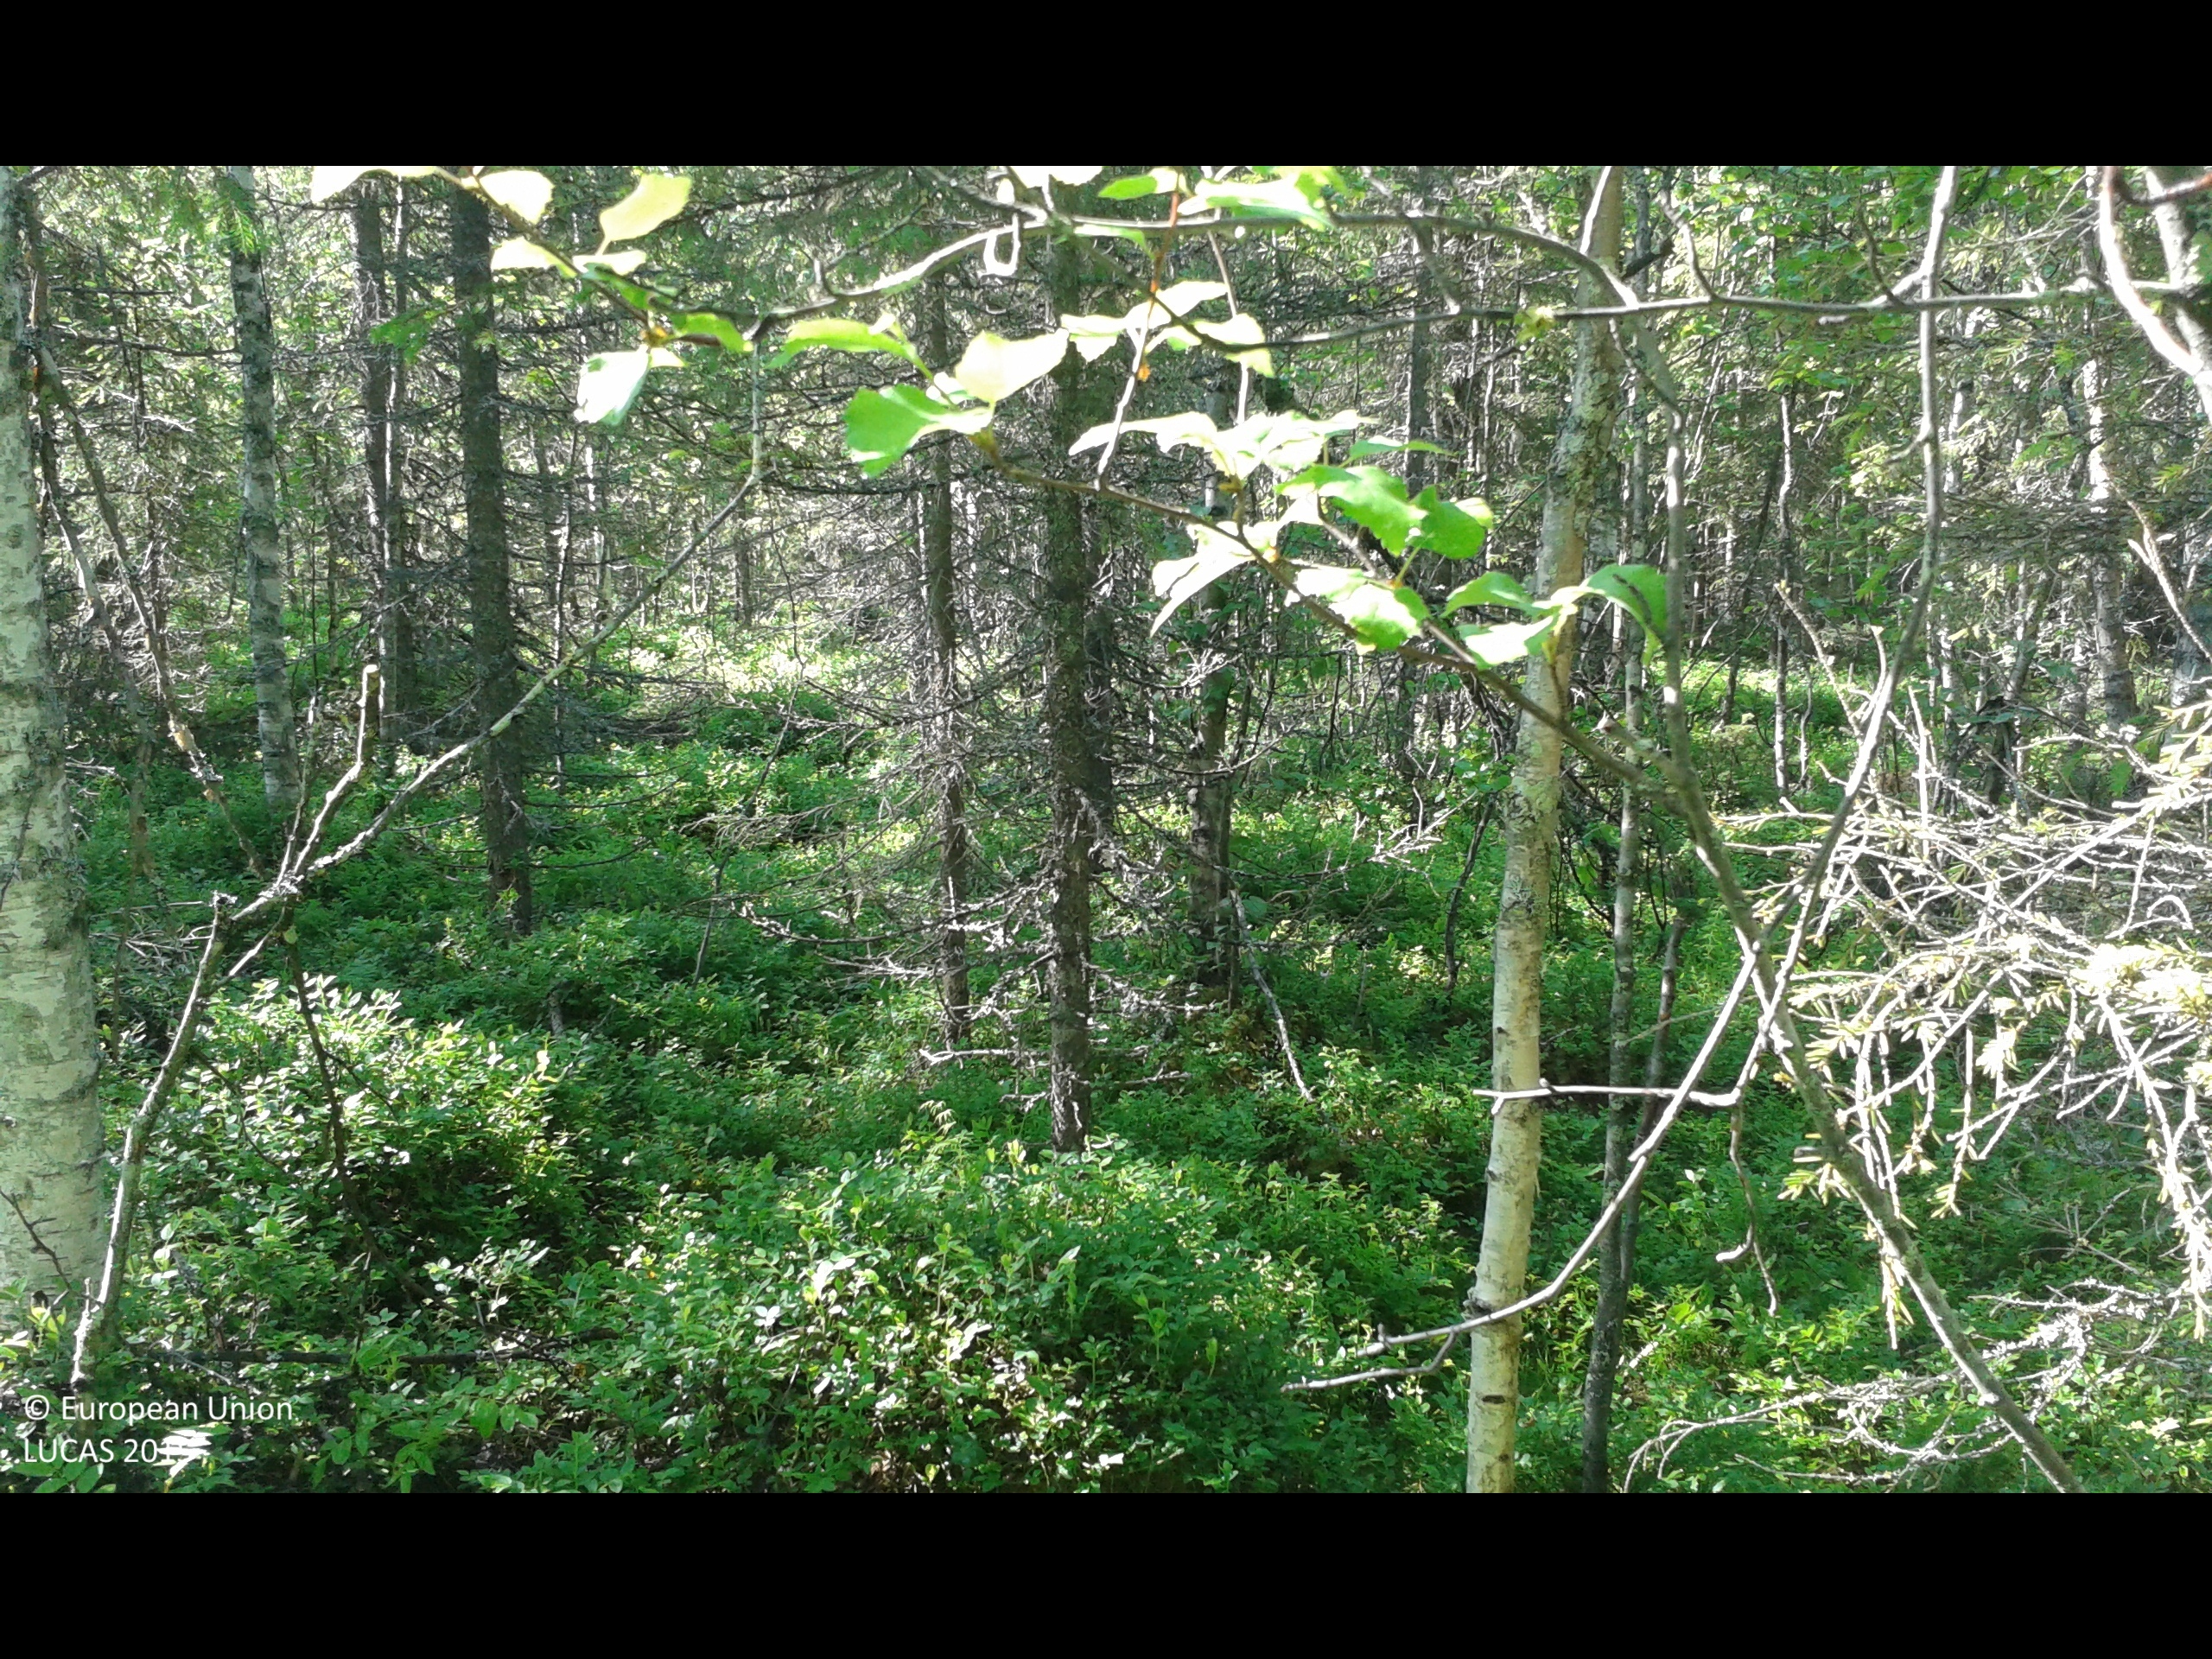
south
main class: Woodland
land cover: Spruce dominated mixed woodland
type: boreal forest
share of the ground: 25 - 50 %
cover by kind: shrubs 55 %, coniferous forest trees 25 %, broadleaved forest trees 20 %
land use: Forestry
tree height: > 5 m
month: July
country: SE
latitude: 66.6186
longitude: 23.6919
